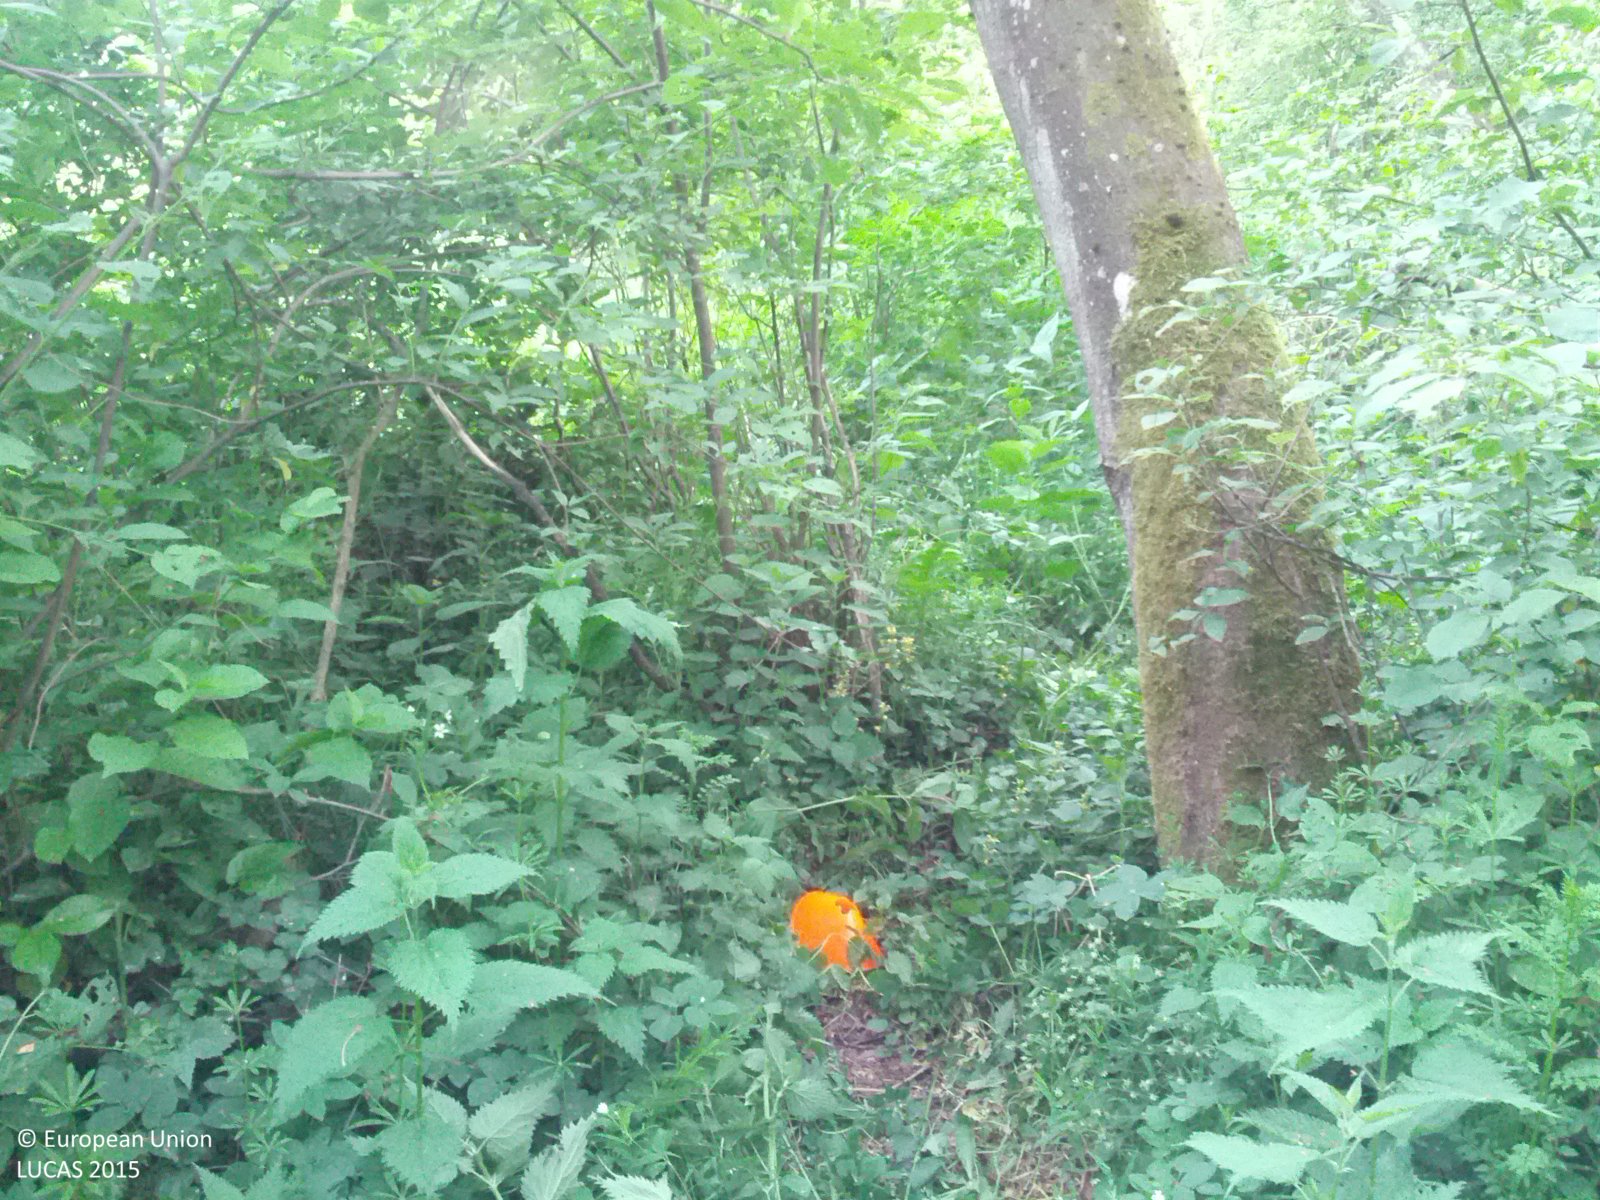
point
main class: Woodland
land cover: Broadleaved woodland
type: floodplain forest
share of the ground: > 75 %
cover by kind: broadleaved forest trees 40 %, shrubs 40 %, herbaceous plants 20 %
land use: Semi-natural and natural areas not in use
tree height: > 5 m
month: May
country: AT
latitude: 47.3325
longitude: 16.1027
